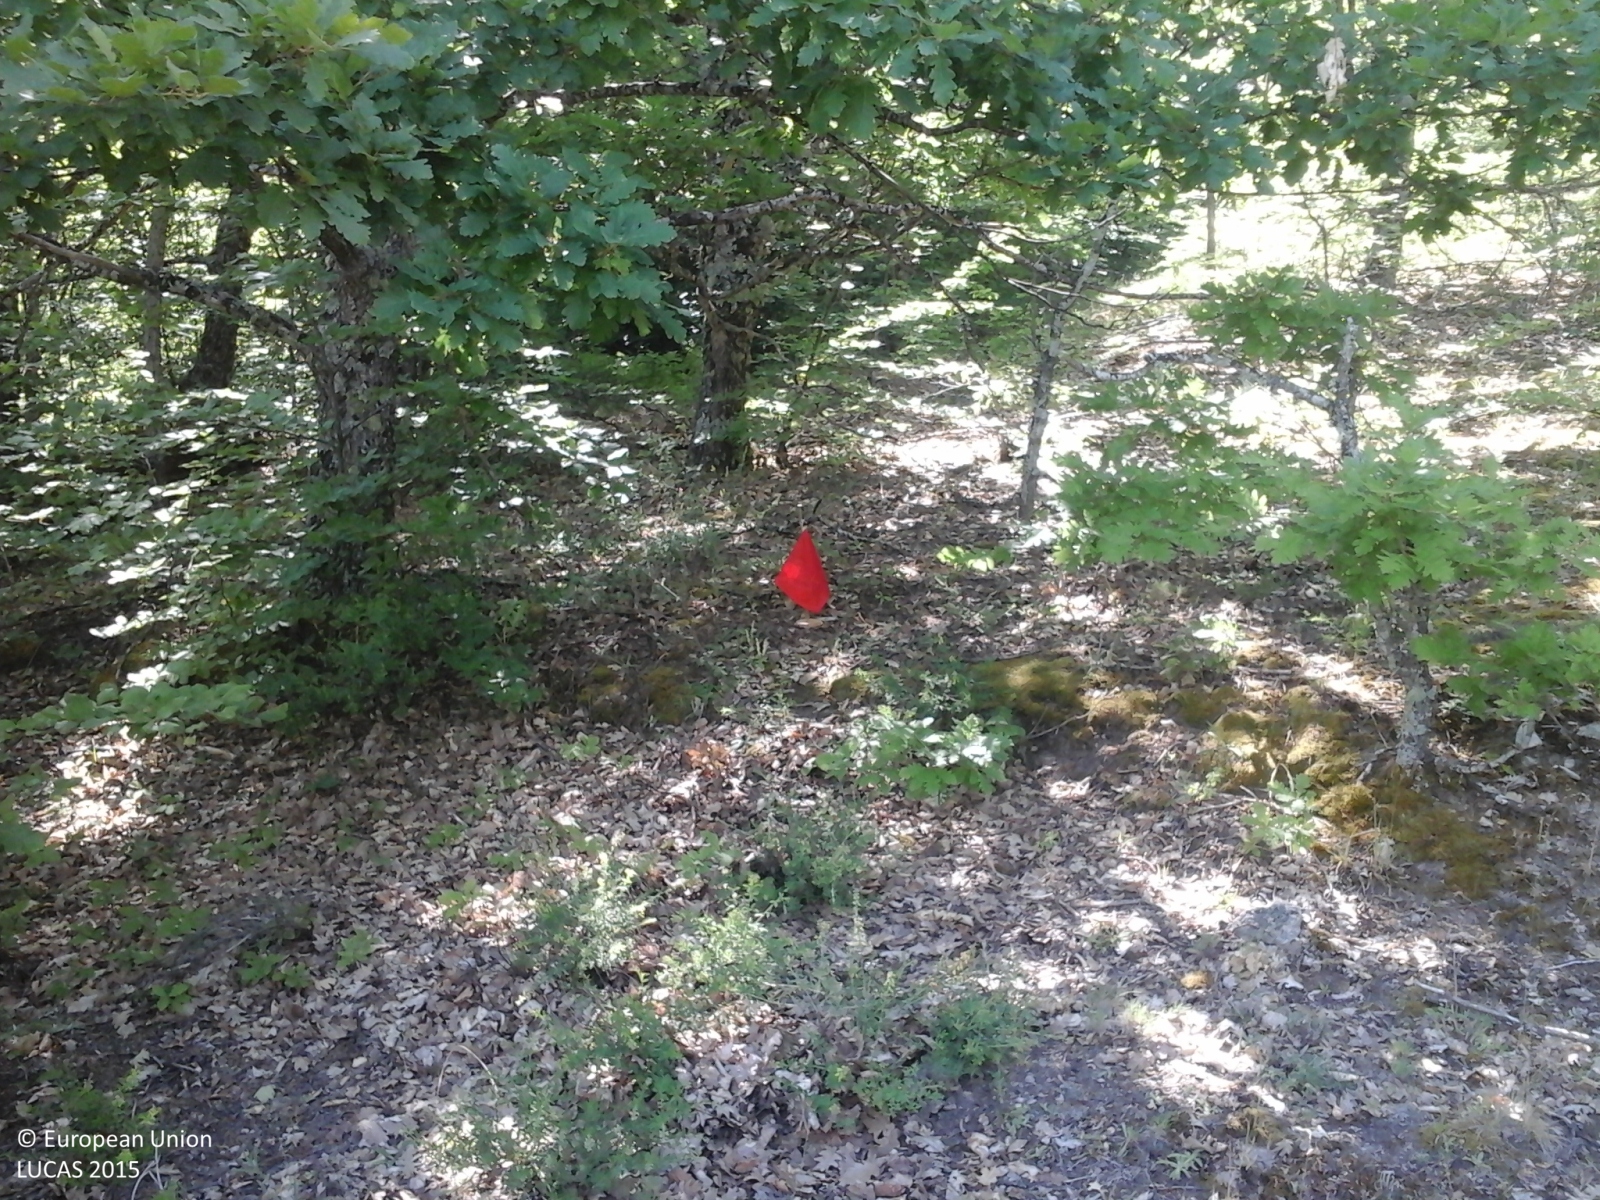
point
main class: Woodland
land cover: Broadleaved woodland
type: thermophilous deciduous forest
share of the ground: > 75 %
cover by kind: broadleaved forest trees 75 %, herbaceous plants 20 %, lichens and mosses 5 %
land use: Forestry
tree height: > 5 m
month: June
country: GR
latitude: 40.6129
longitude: 21.3264
